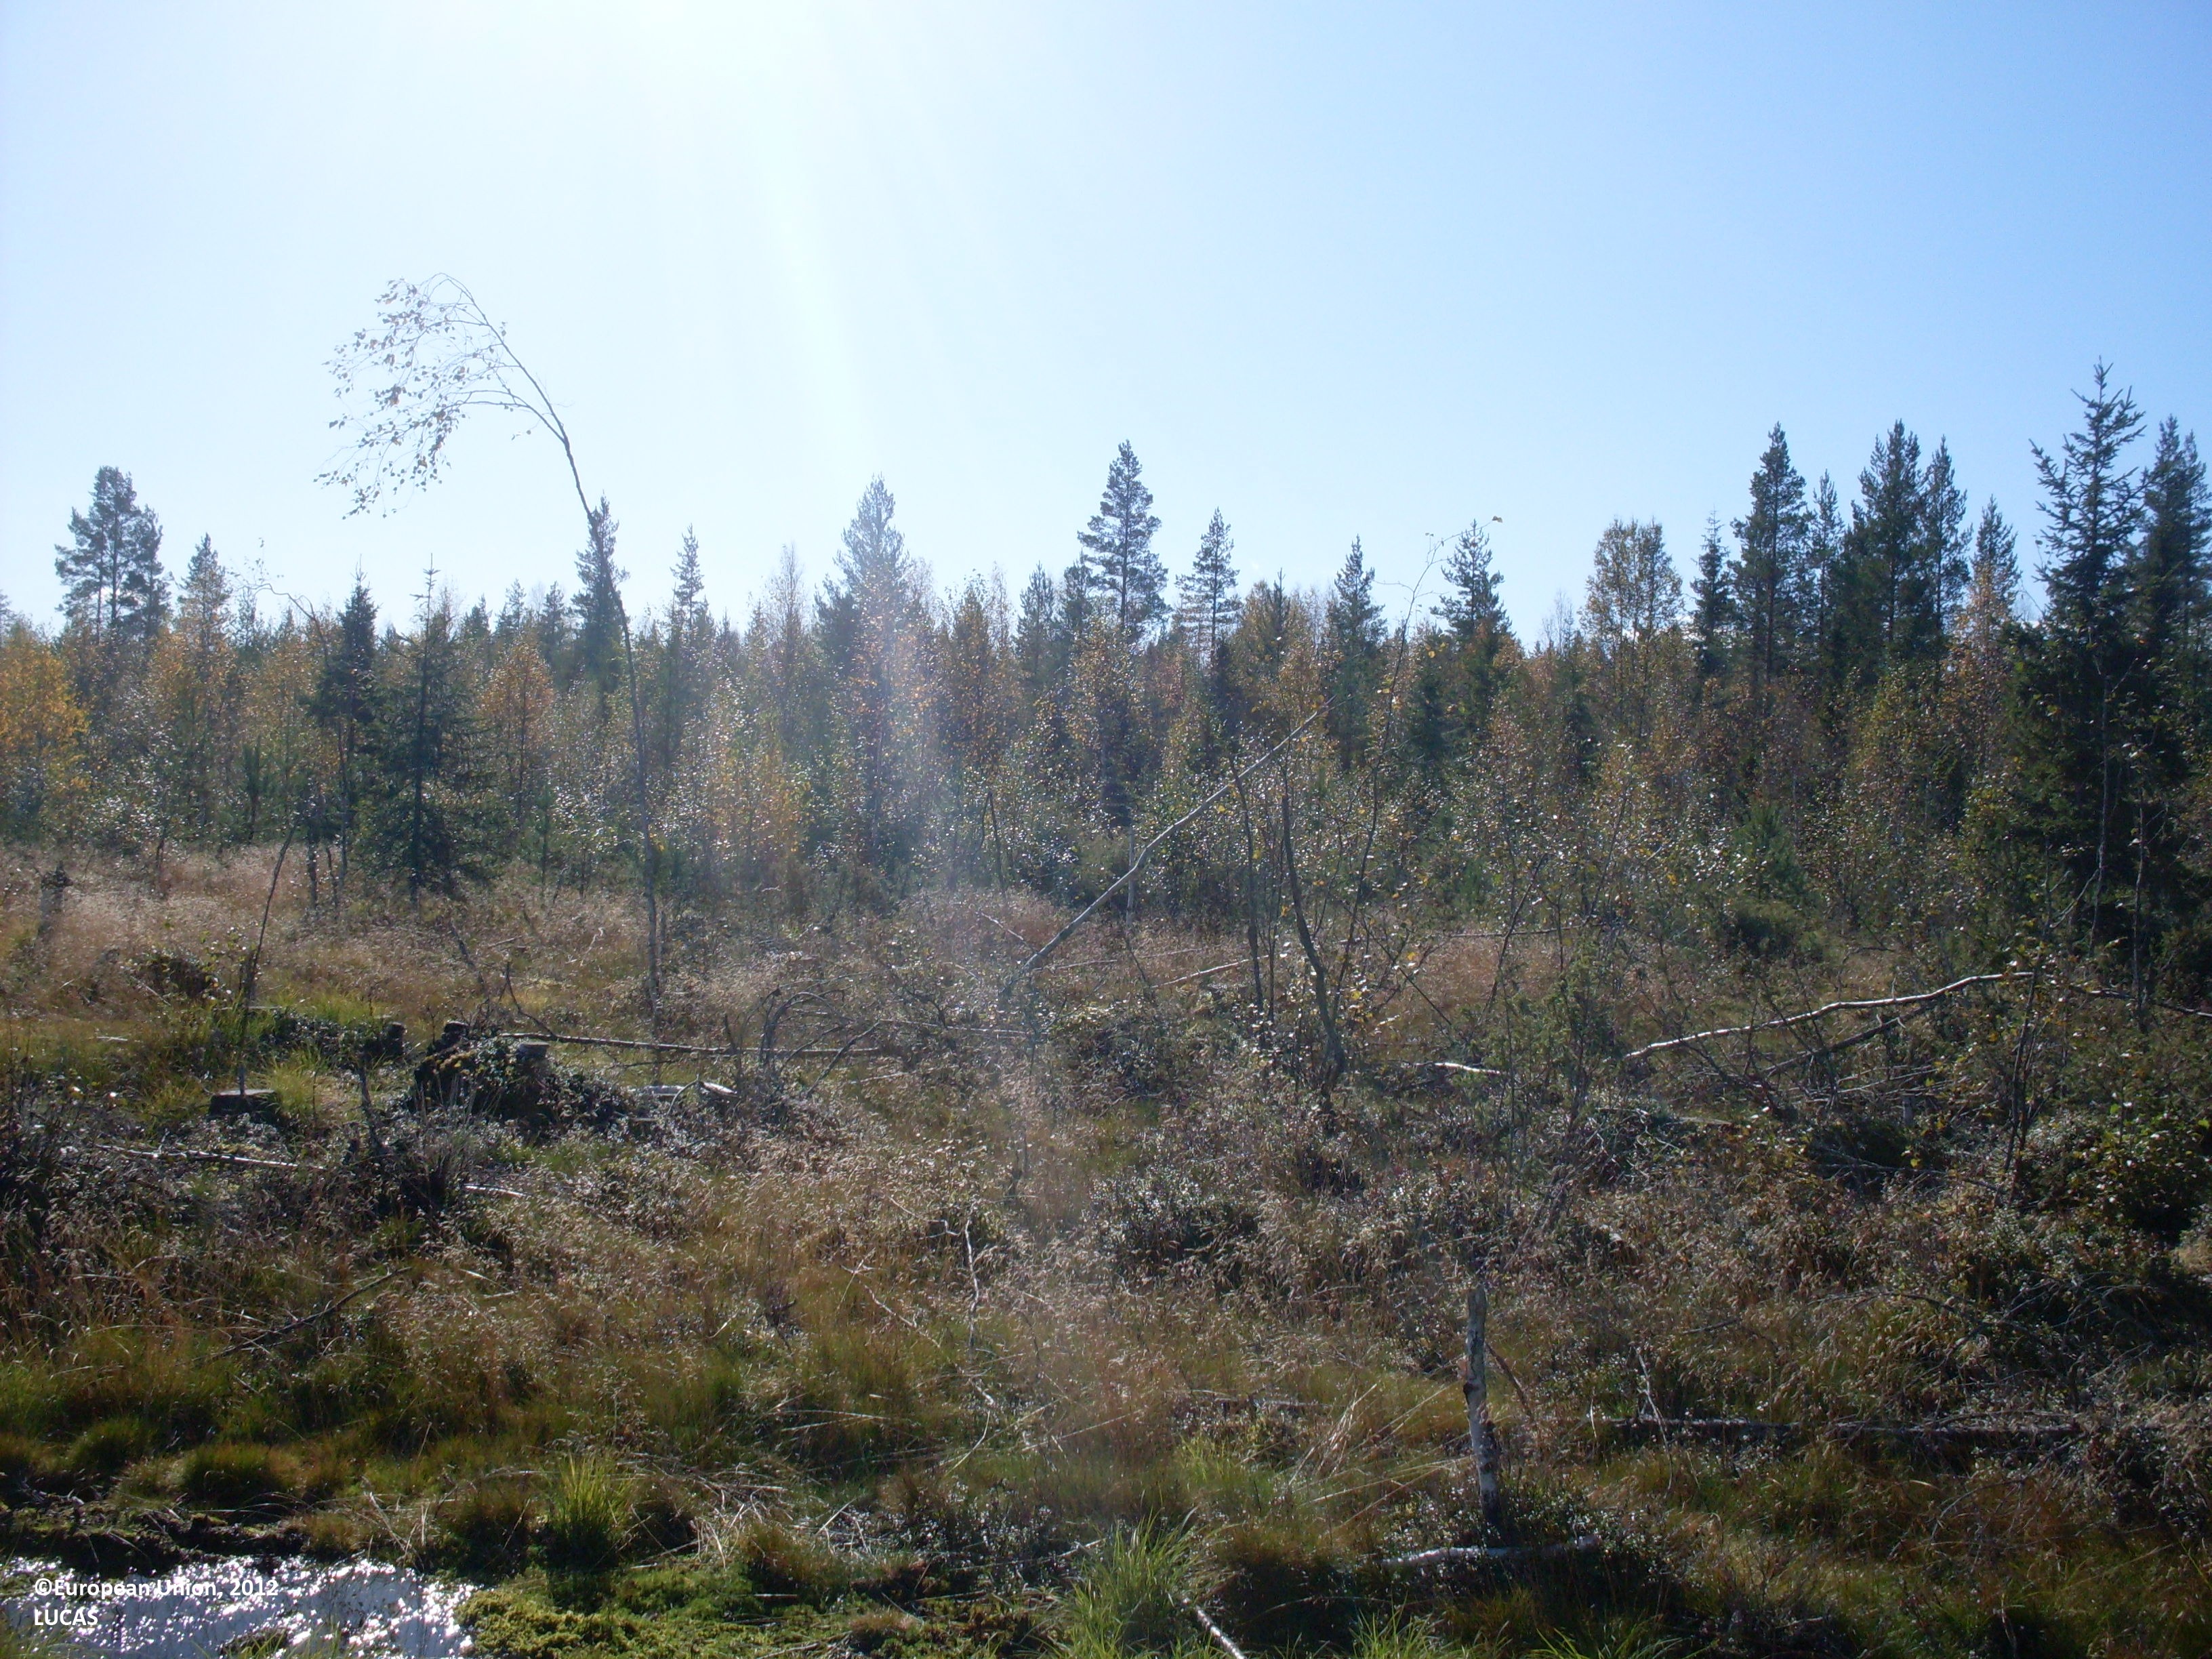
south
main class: Woodland
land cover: Pine dominated mixed woodland
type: boreal forest
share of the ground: 50 - 75 %
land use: Forestry
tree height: > 5 m
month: September
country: FI
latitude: 64.3059
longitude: 28.4725
